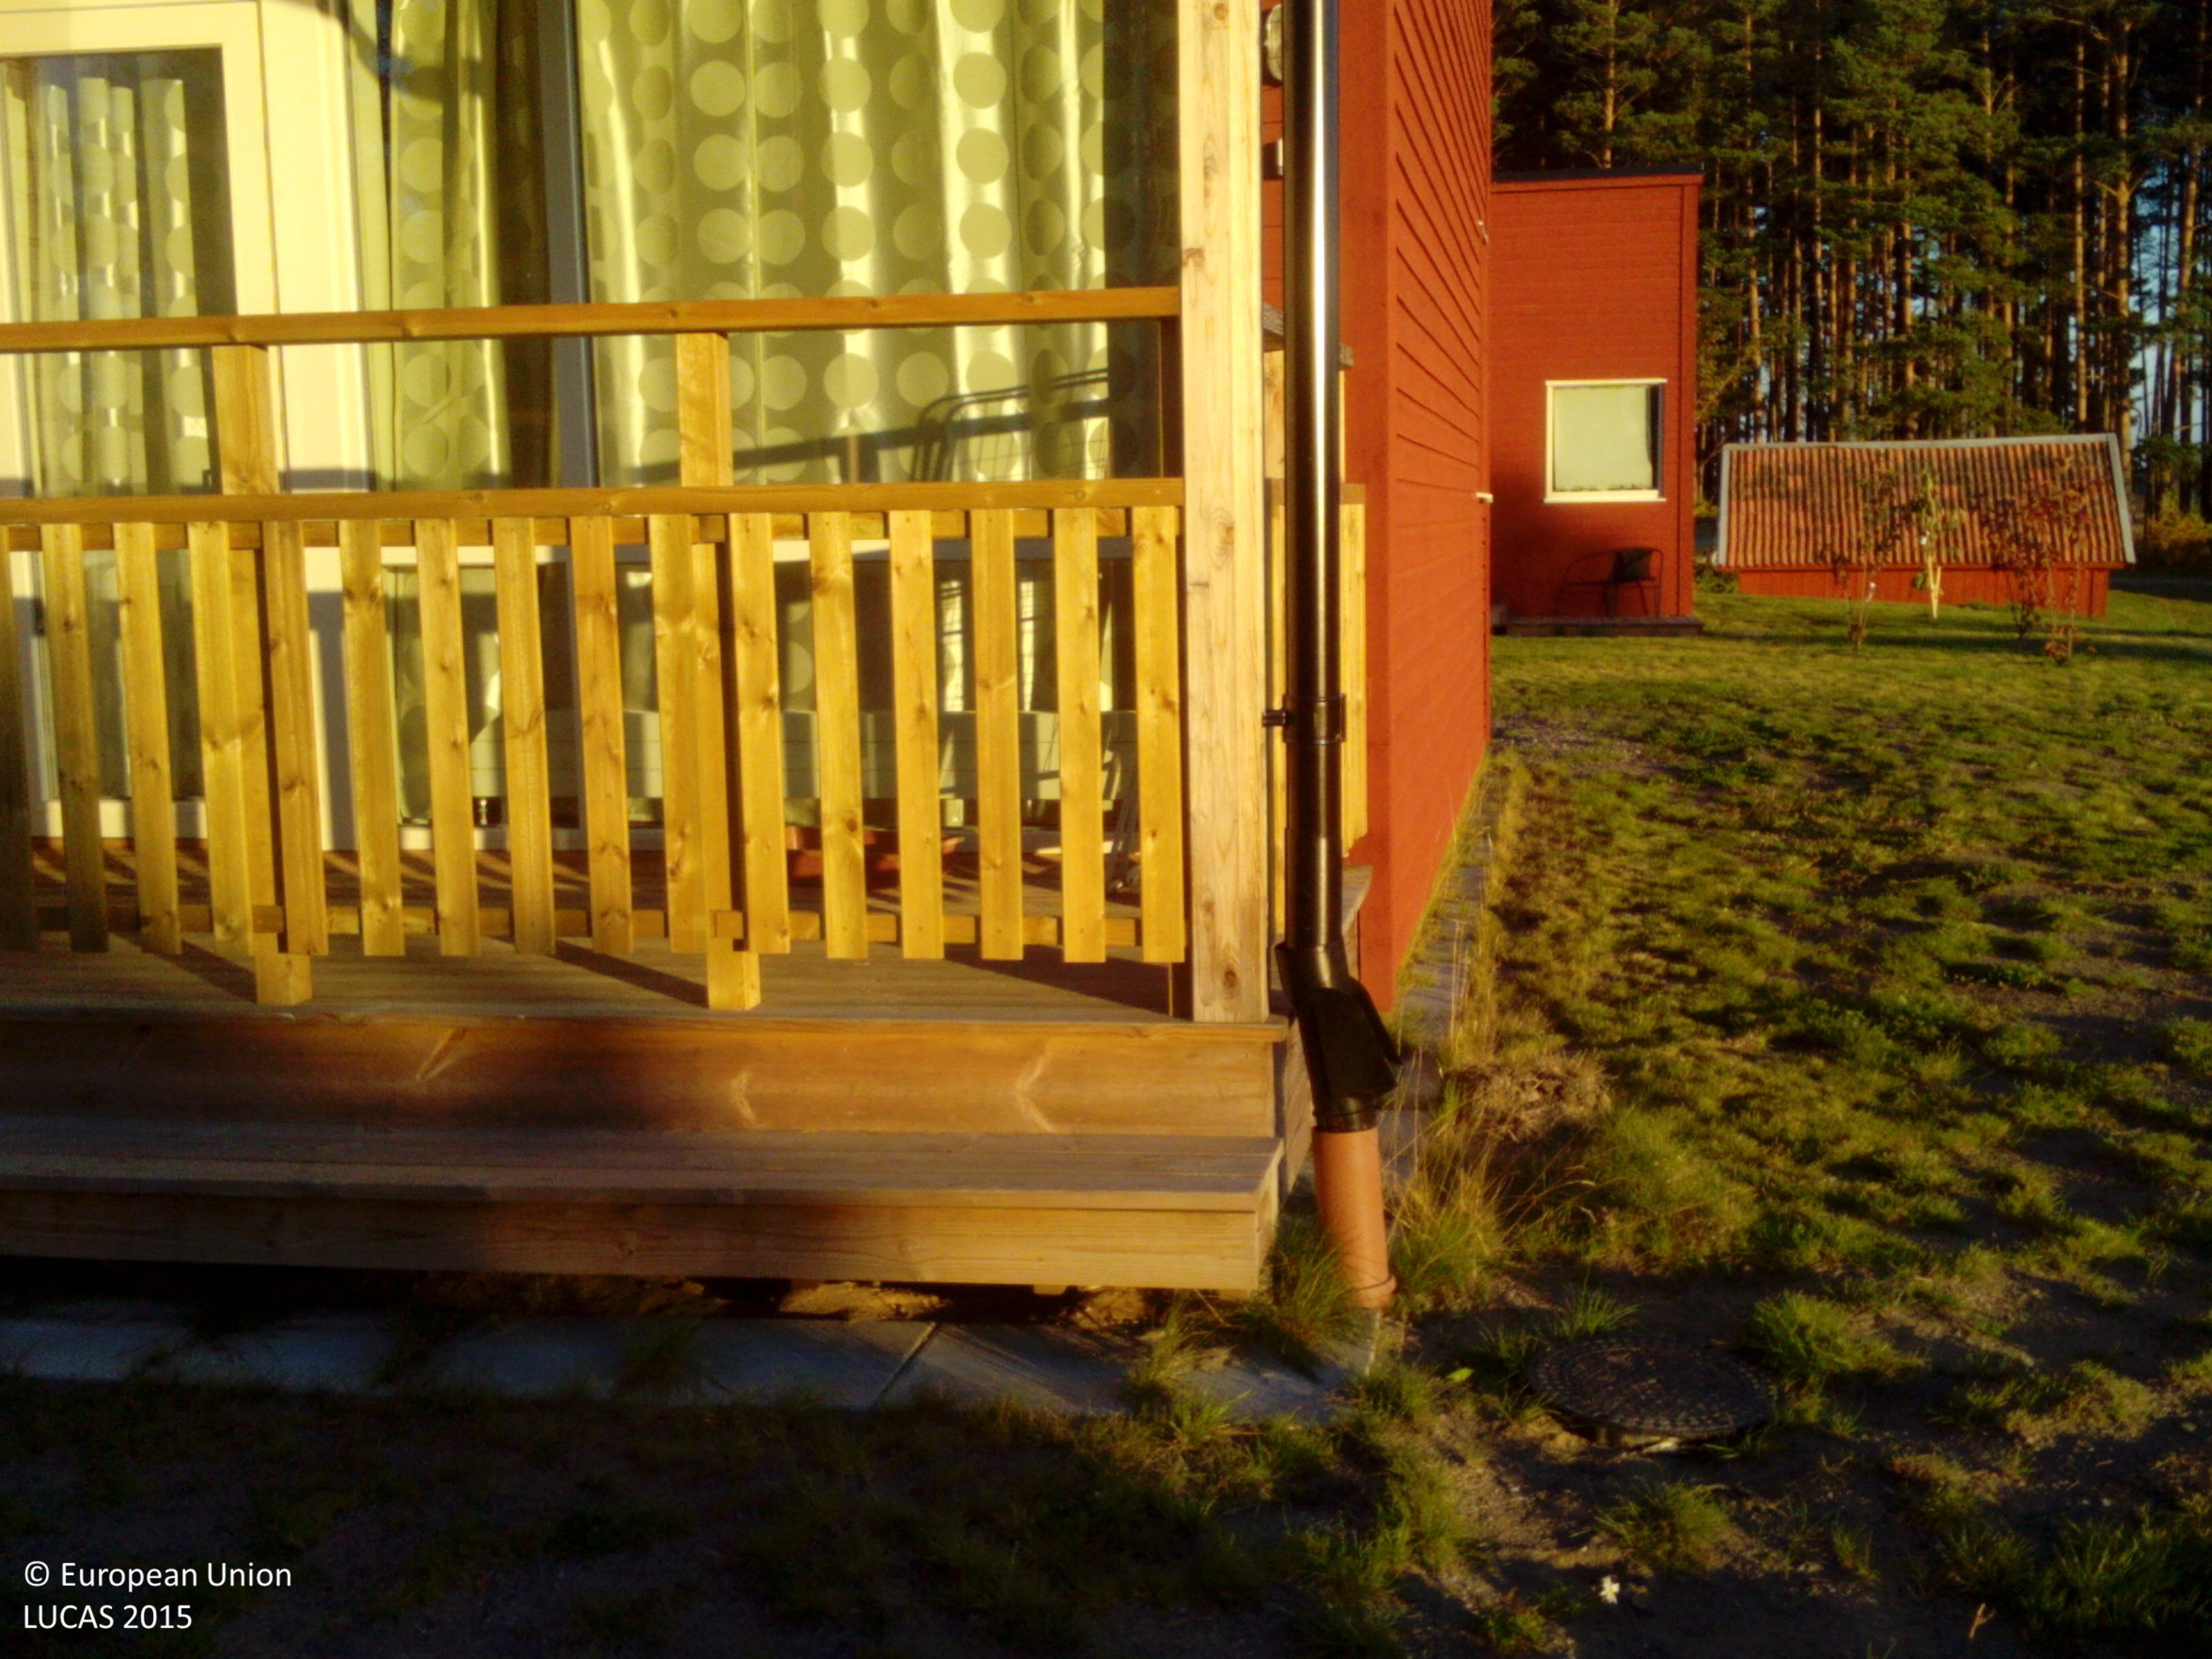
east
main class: Grassland
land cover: Grassland without tree/shrub cover
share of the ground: > 75 %
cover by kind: herbaceous plants 80 %
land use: Residential
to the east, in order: Grassland without tree/shrub cover; Artificial constructions in urban areas; Grassland without tree/shrub cover; Paved roads, cycling and walking lanes; Other coniferous woodland; Spruce dominated coniferous woodland; Grassland with sparse tree/shrub cover; Electric lines; Other coniferous woodland; Pine dominated coniferous woodland; Tracks; Fences; Artificial constructions in urban areas
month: October
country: SE
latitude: 58.8060
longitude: 16.7987
